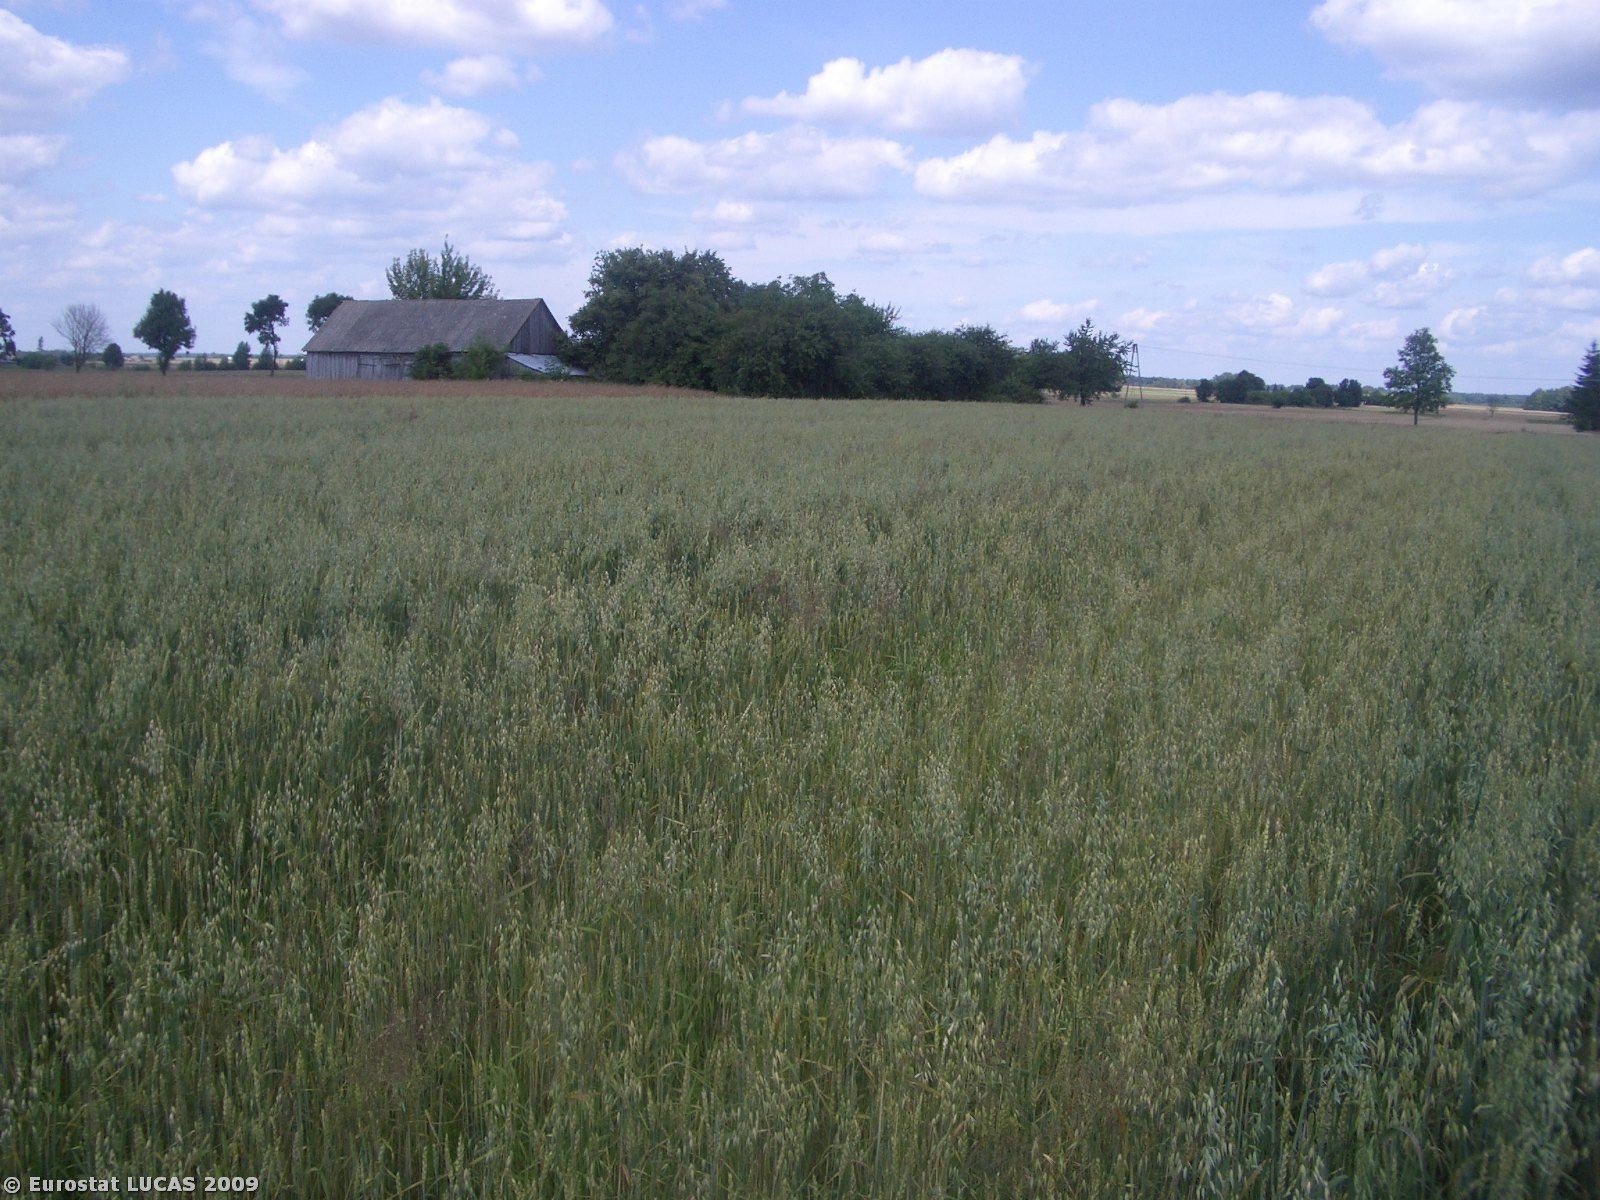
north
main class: Cropland
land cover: Oats
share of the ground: > 75 %
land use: Agriculture (excluding fallow land and kitchen gardens)
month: July
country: PL
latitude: 52.1464
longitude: 23.0381
